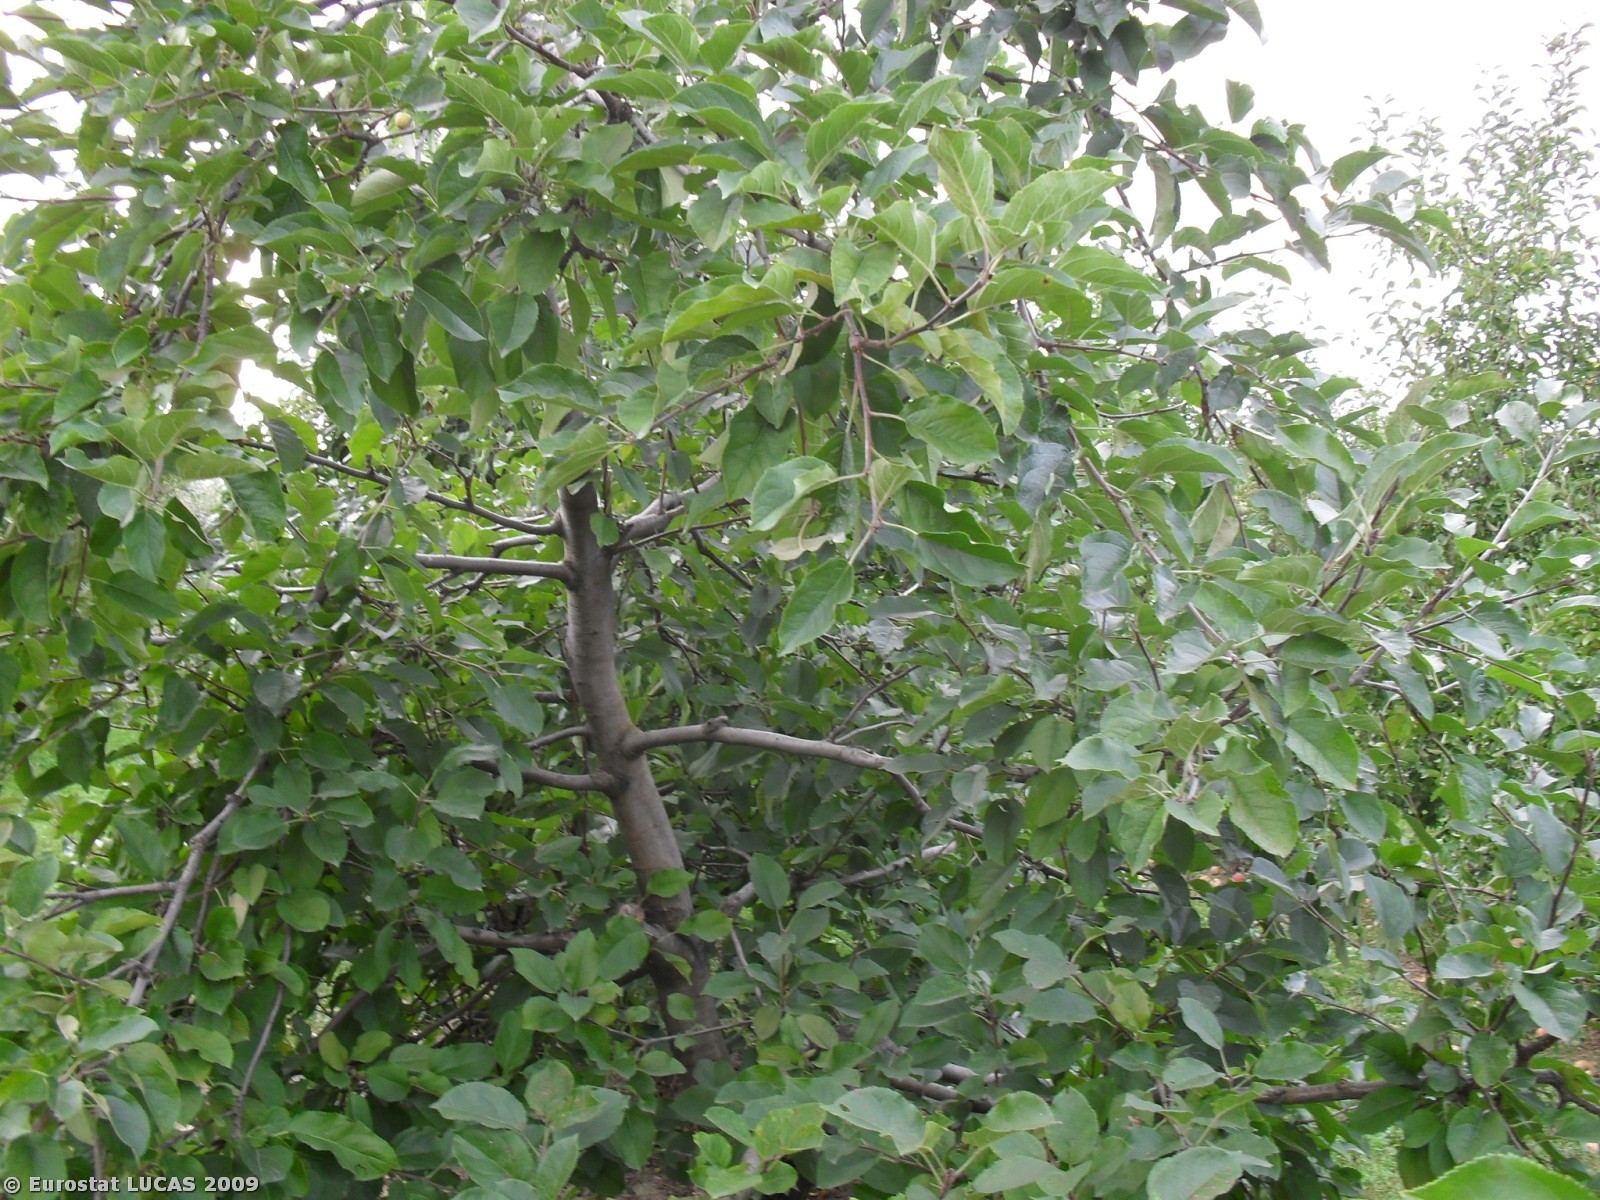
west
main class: Cropland
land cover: Apple fruit
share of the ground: 50 - 75 %
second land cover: Grassland with sparse tree/shrub cover
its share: > 75 %
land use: Agriculture (excluding fallow land and kitchen gardens)
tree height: < 5 m
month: September
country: PL
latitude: 51.6446
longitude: 20.6328
